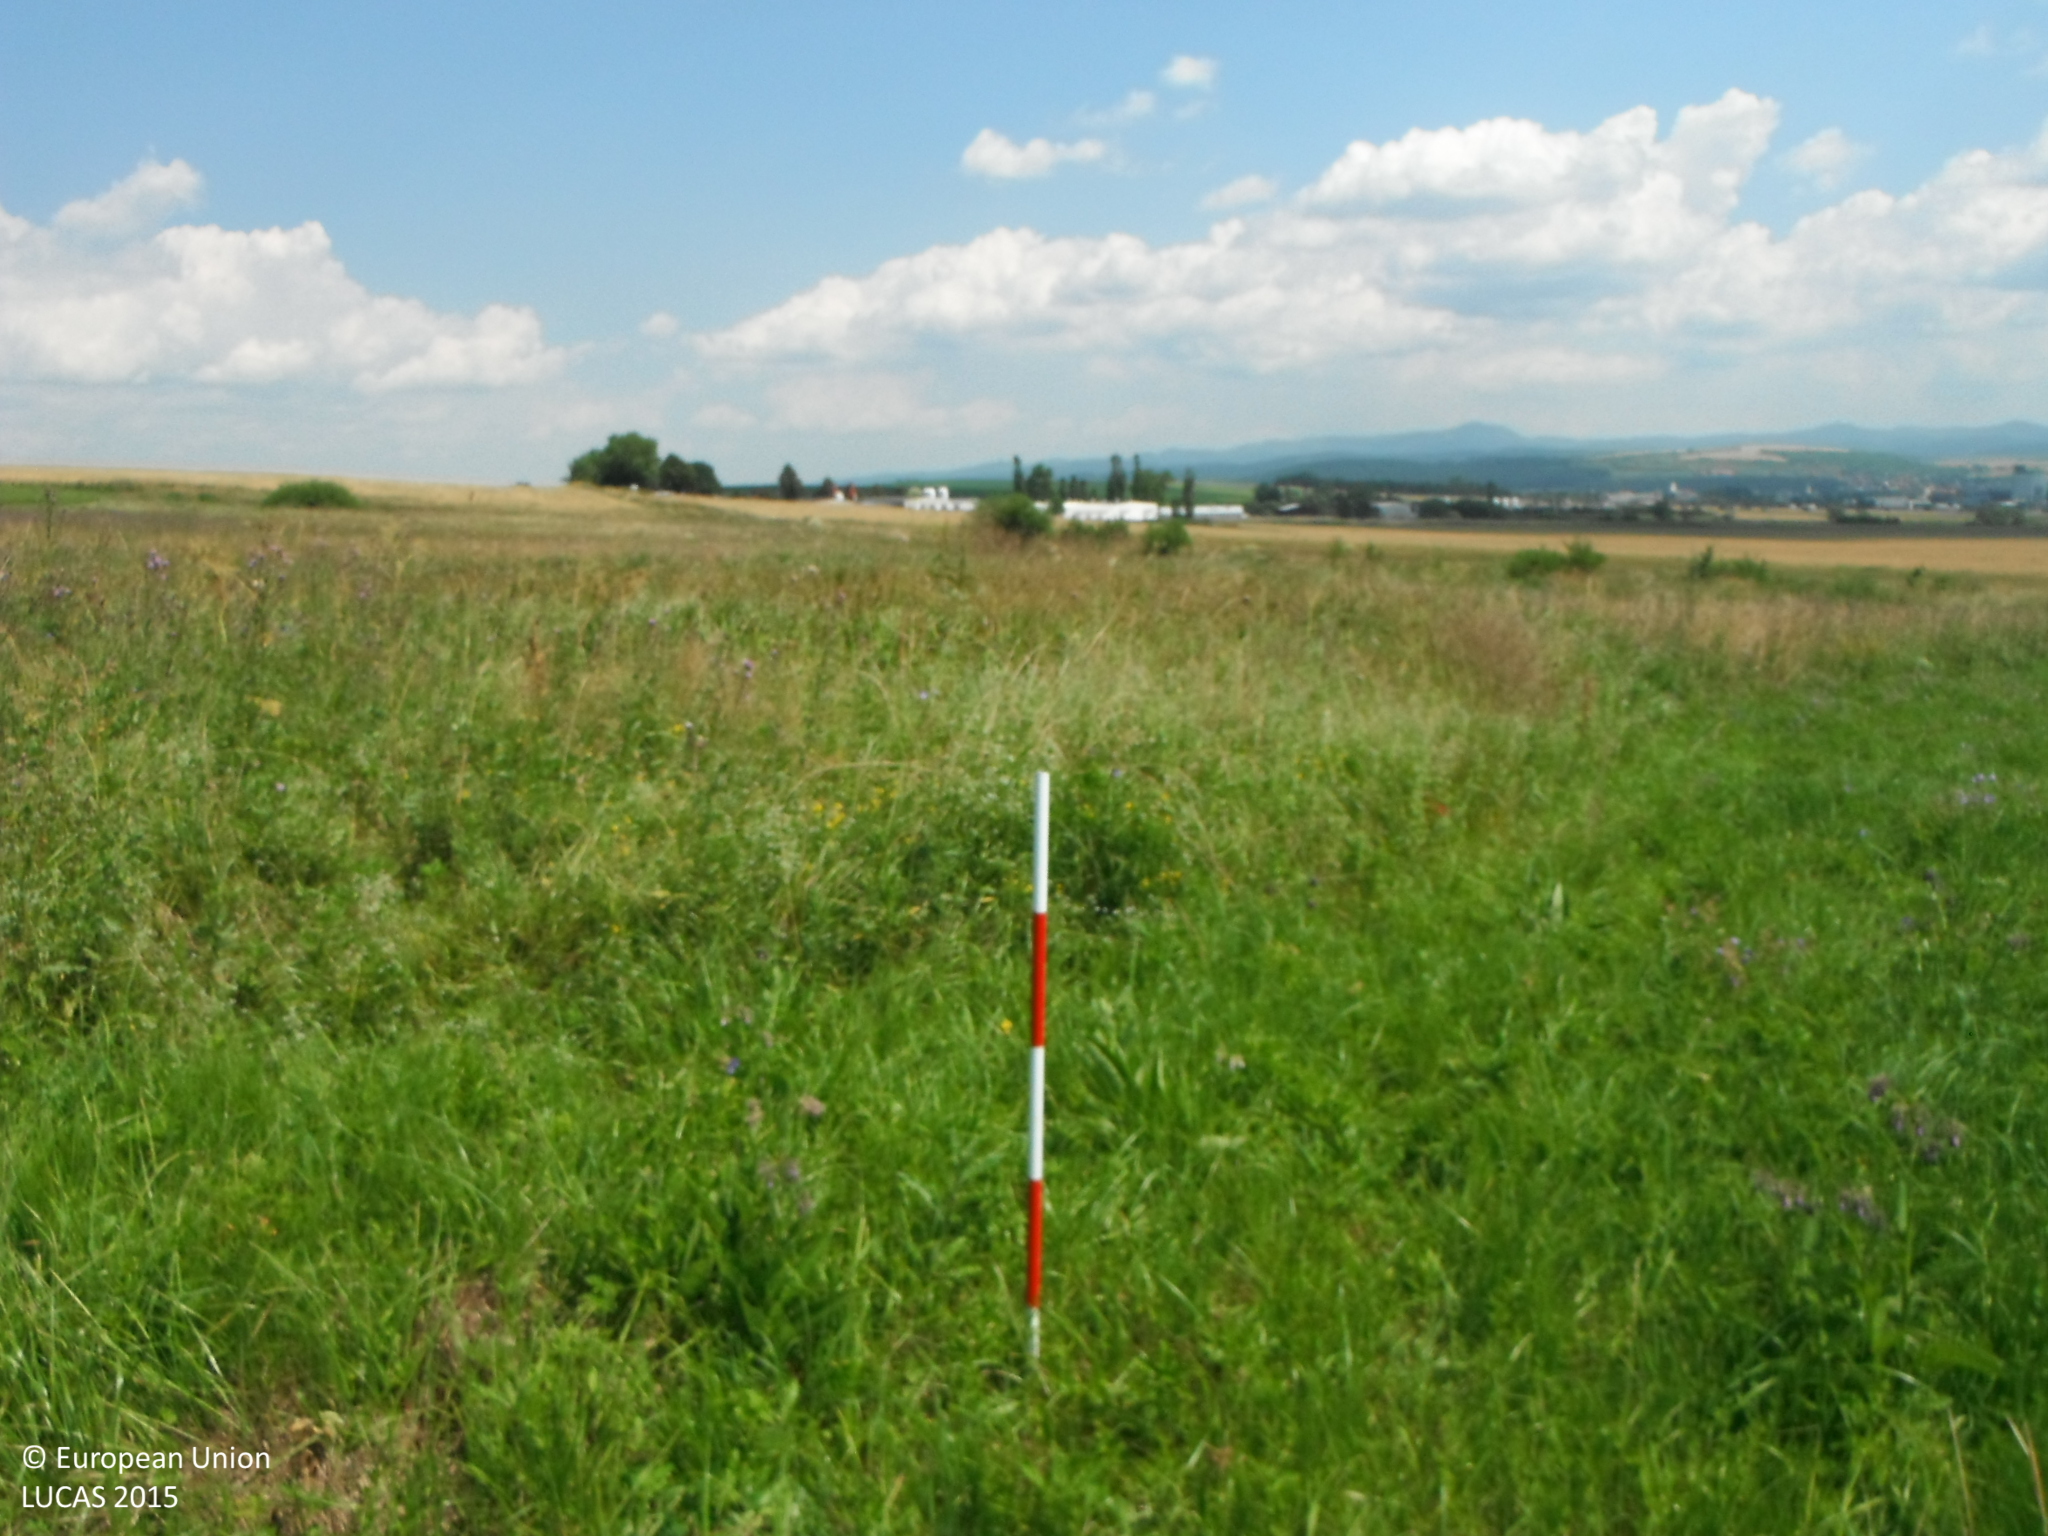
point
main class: Grassland
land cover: Grassland without tree/shrub cover
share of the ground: > 75 %
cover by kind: herbaceous plants 100 %
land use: Agriculture (excluding fallow land and kitchen gardens)
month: July
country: SK
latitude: 49.1287
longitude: 20.3817
